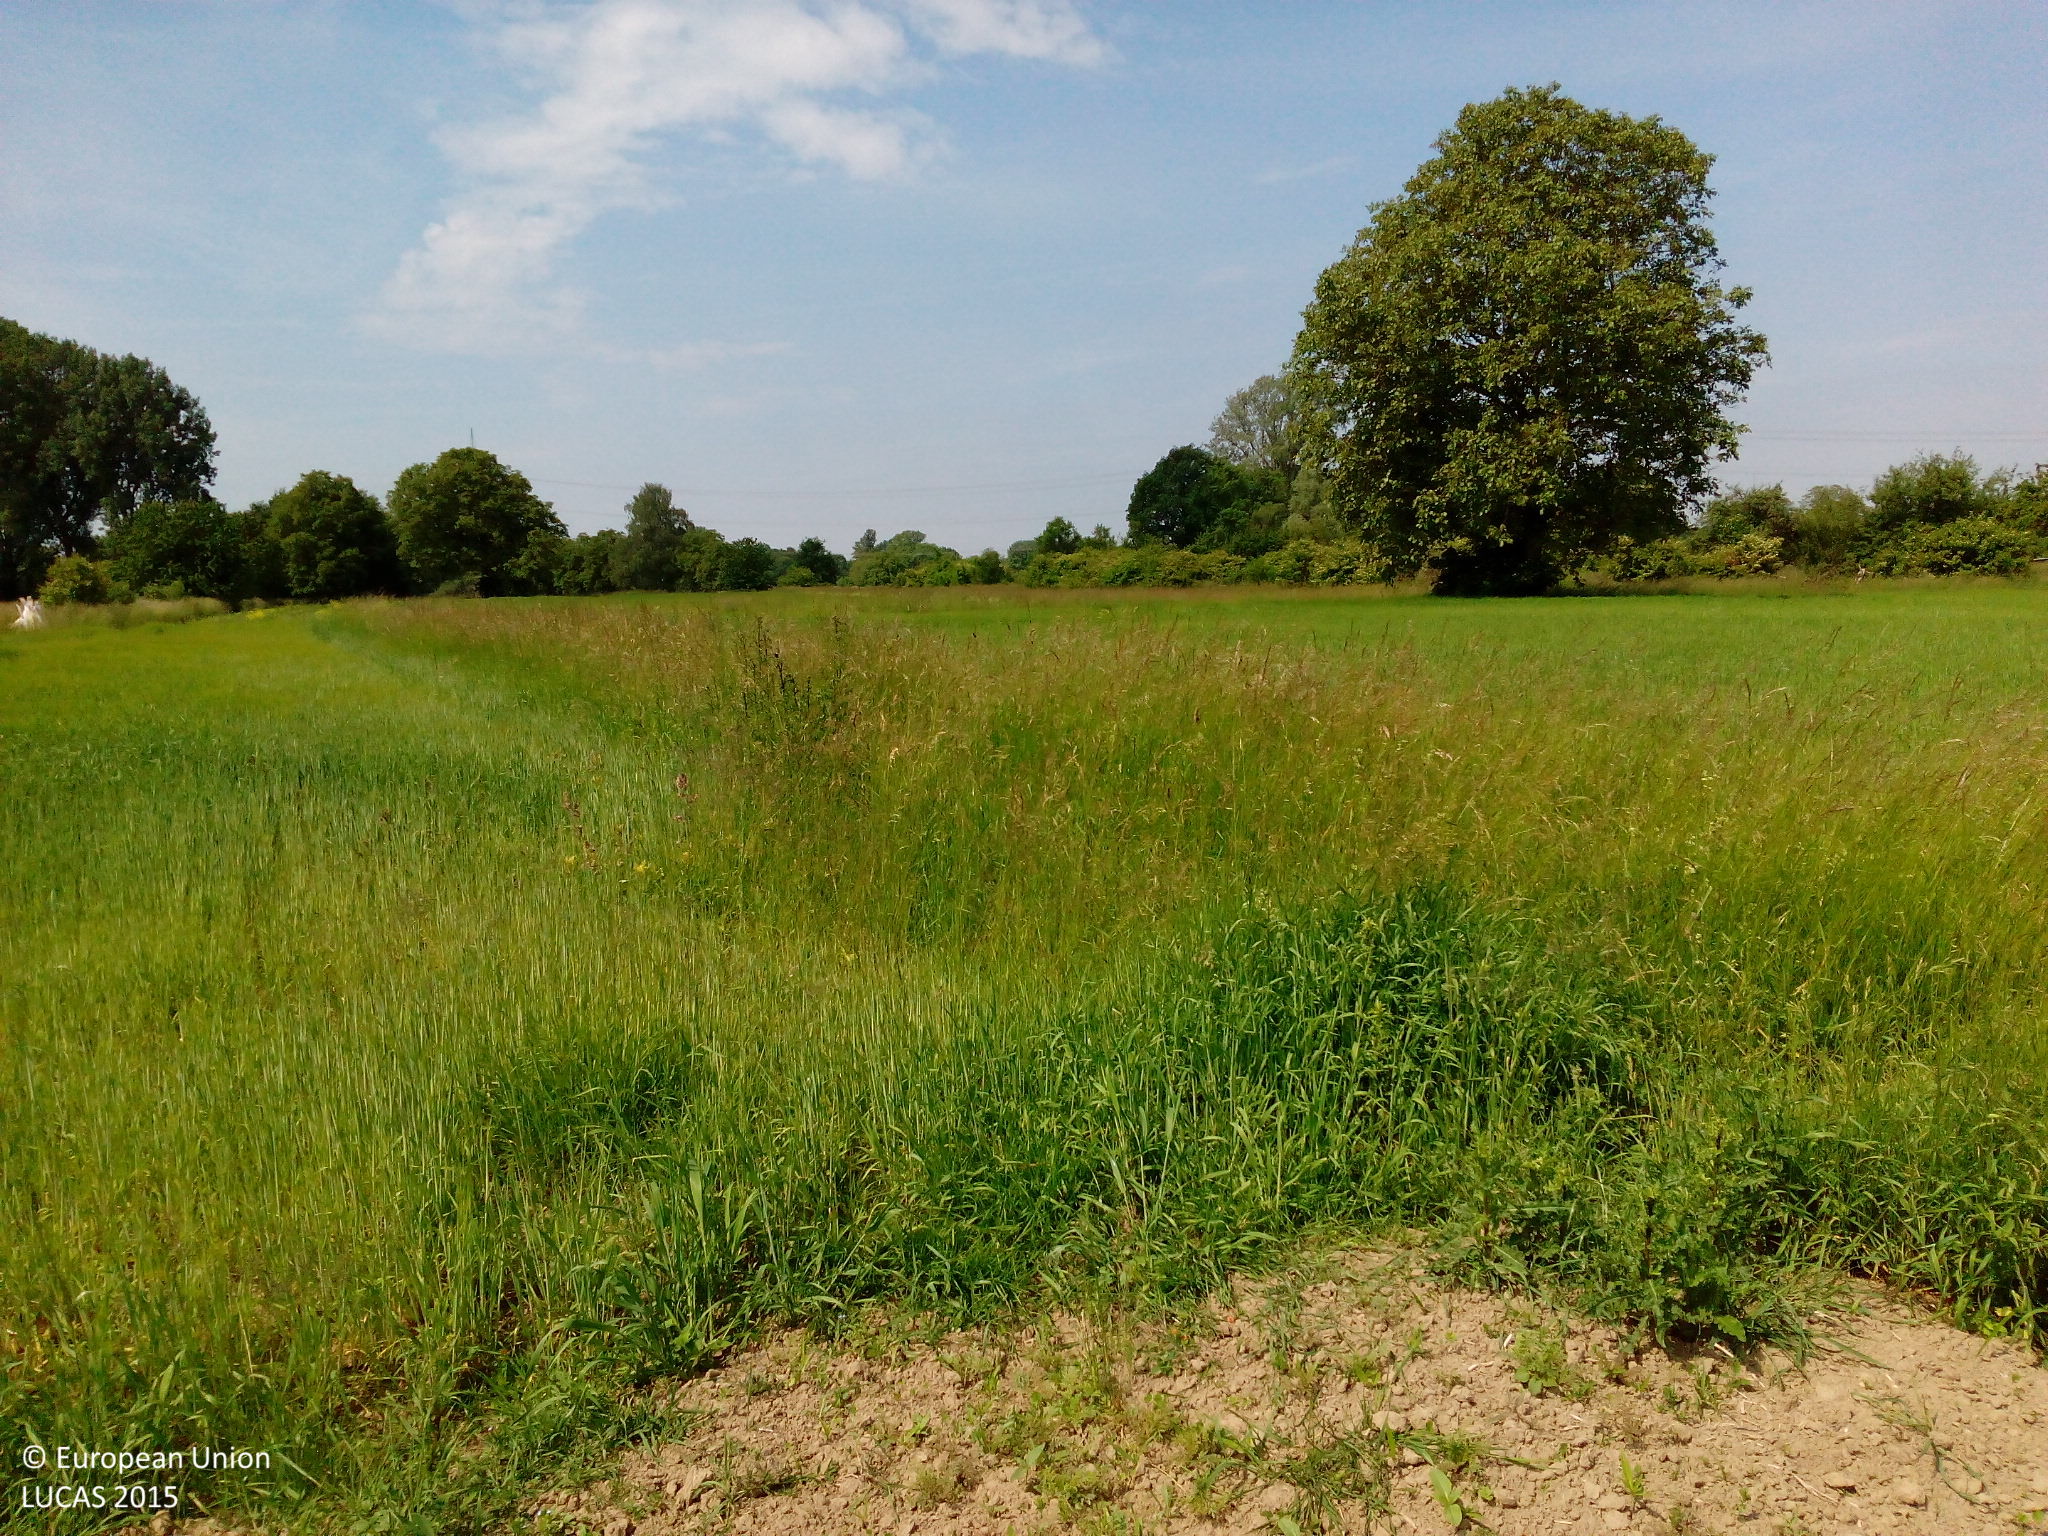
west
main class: Cropland
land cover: Other leguminous and mixtures for fodder
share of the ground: < 10 %
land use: Agriculture (excluding fallow land and kitchen gardens)
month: May
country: DE
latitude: 48.8925
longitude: 8.1866
